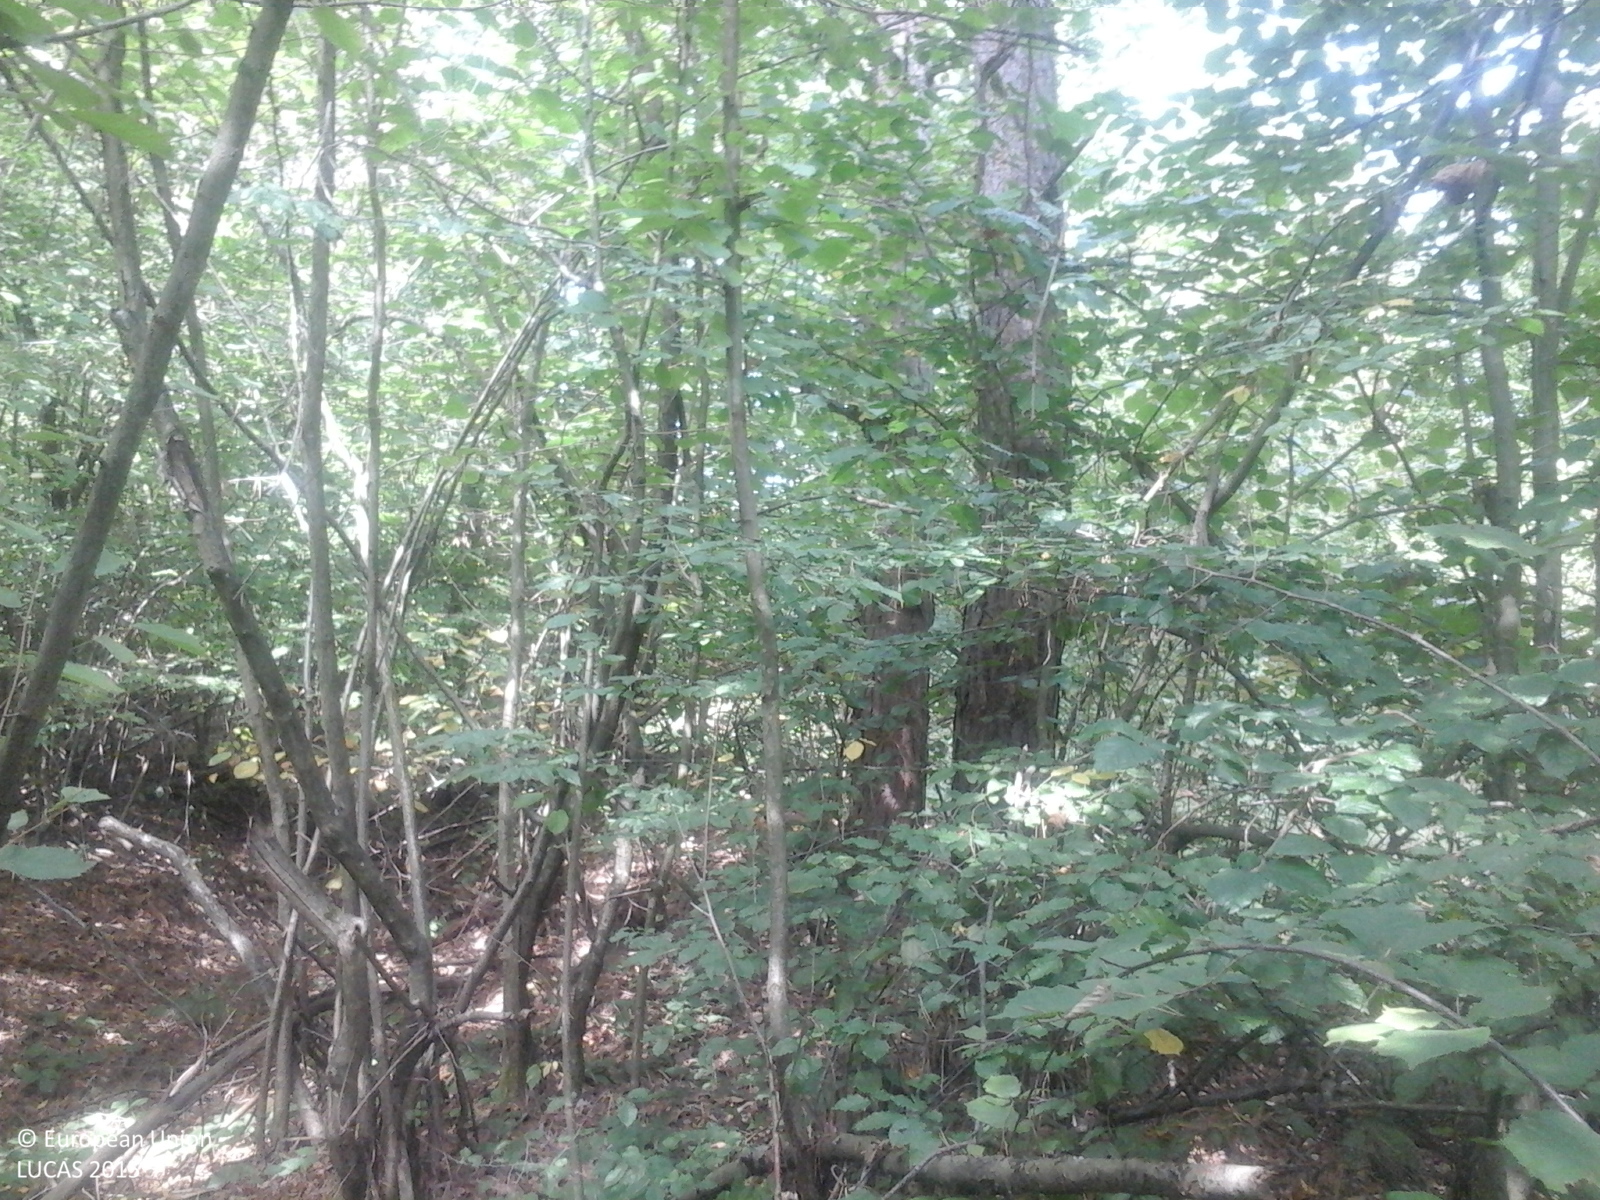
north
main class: Woodland
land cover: Pine dominated mixed woodland
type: hemiboreal forest and nemoral coniferous forest and mixed broadleaved-coniferous forest
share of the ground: > 75 %
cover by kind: coniferous forest trees 75 %, broadleaved forest trees 25 %
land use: Forestry
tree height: > 5 m
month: September
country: RO
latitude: 47.4462
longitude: 24.0484
